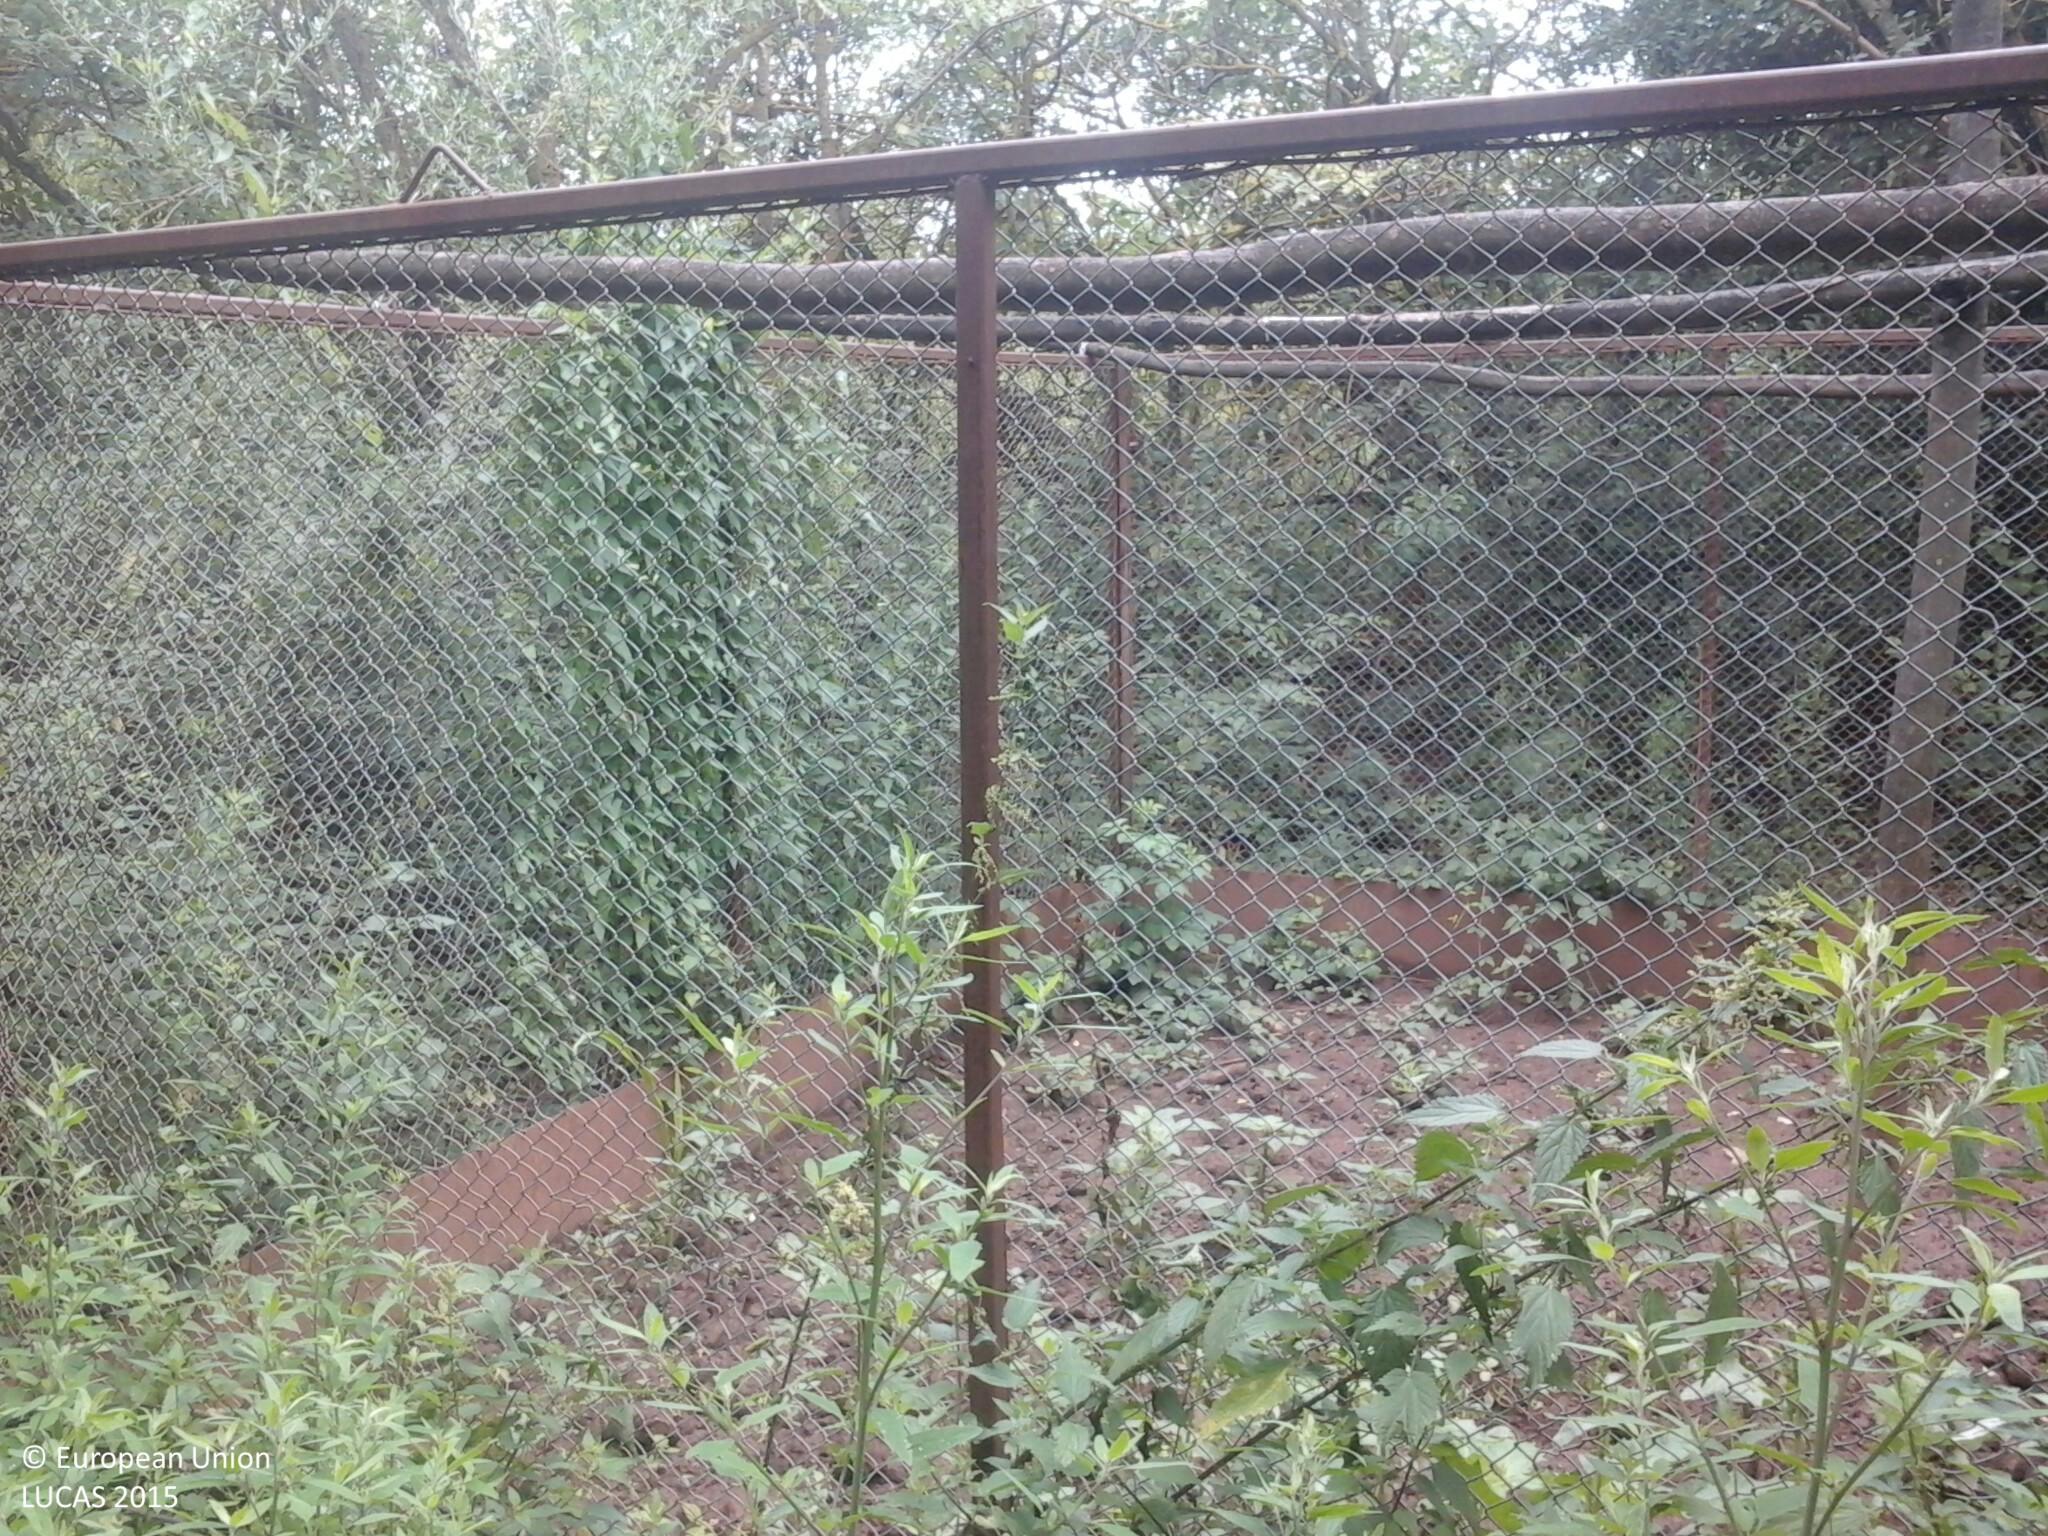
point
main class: Shrubland
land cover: Shrubland with sparse tree cover
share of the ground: > 75 %
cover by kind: shrubs 75 %, herbaceous plants 20 %, broadleaved forest trees 5 %
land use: Abandoned areas
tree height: > 5 m
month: July
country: HU
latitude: 46.9787
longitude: 17.9357
